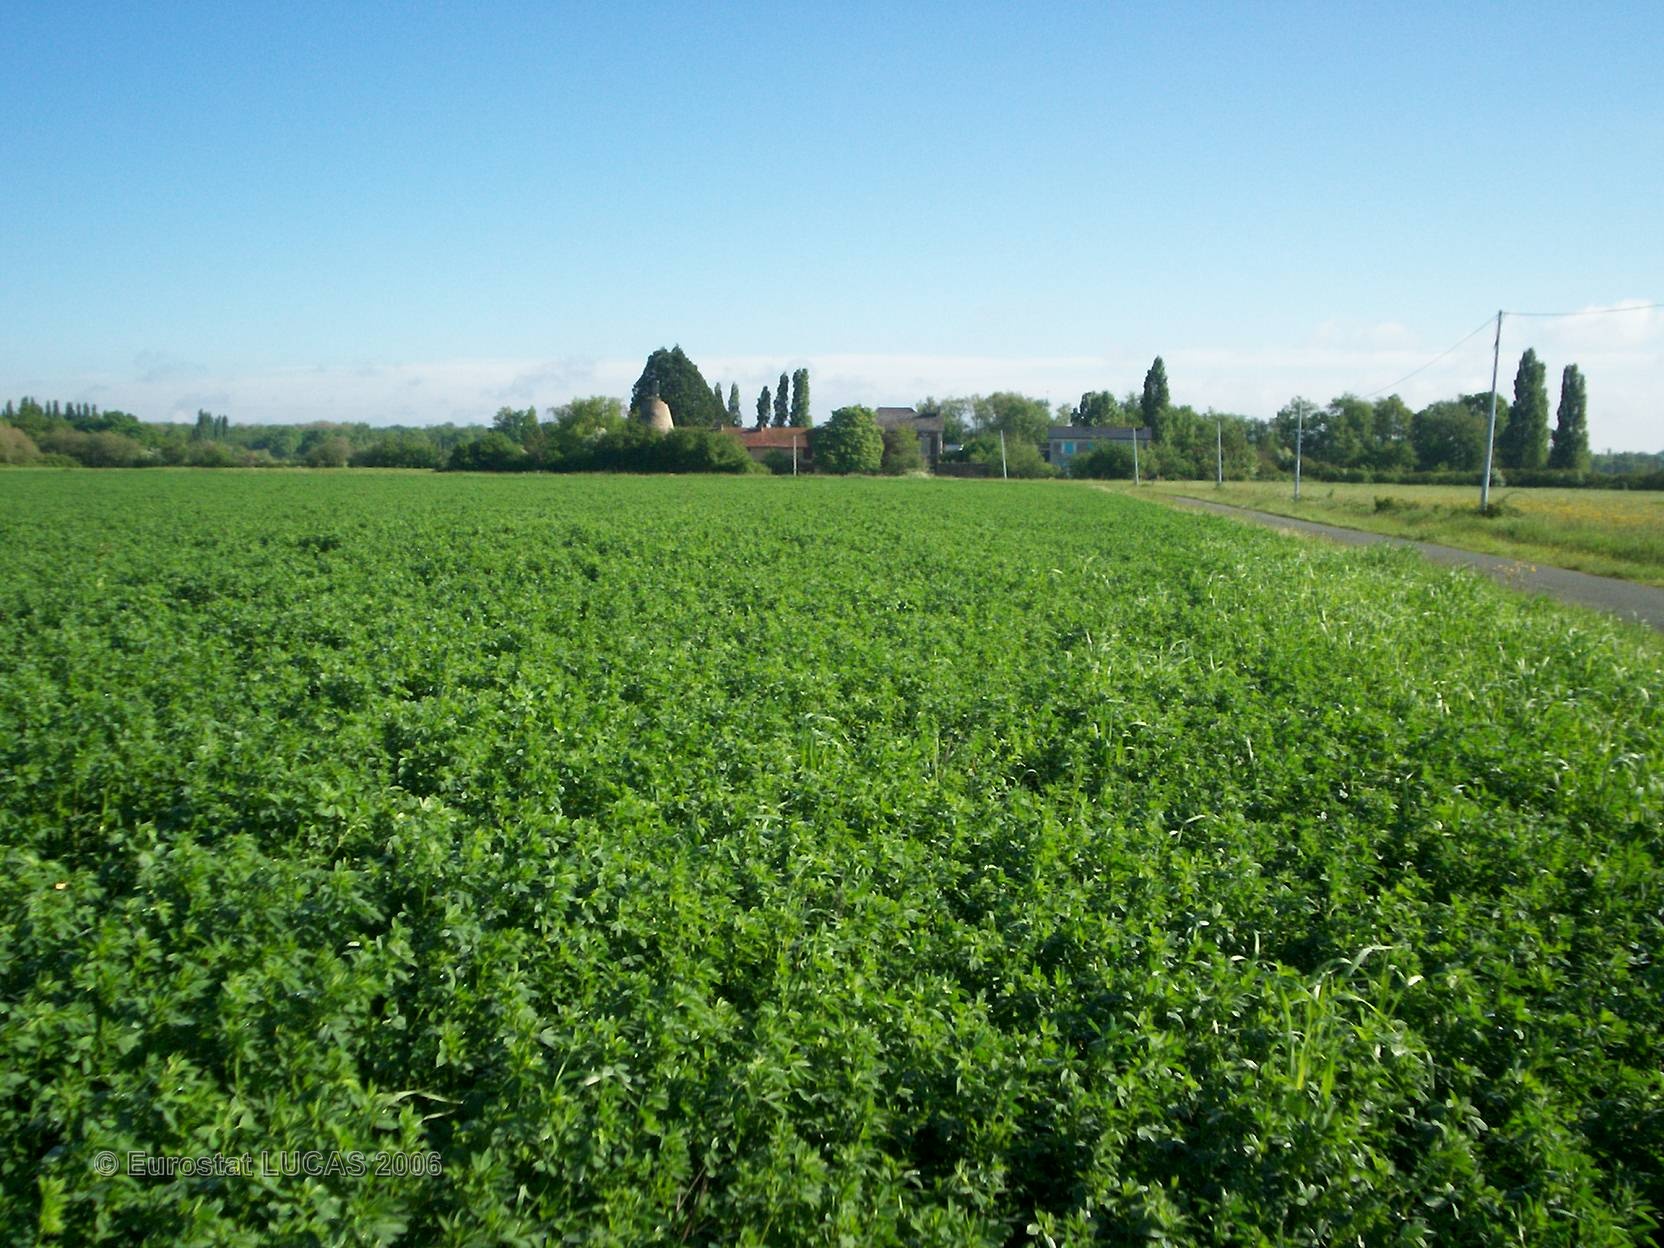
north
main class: Cropland
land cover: Lucerne
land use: Agriculture (excluding fallow land and kitchen gardens)
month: May
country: FR
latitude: 47.2074
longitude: -0.3657
